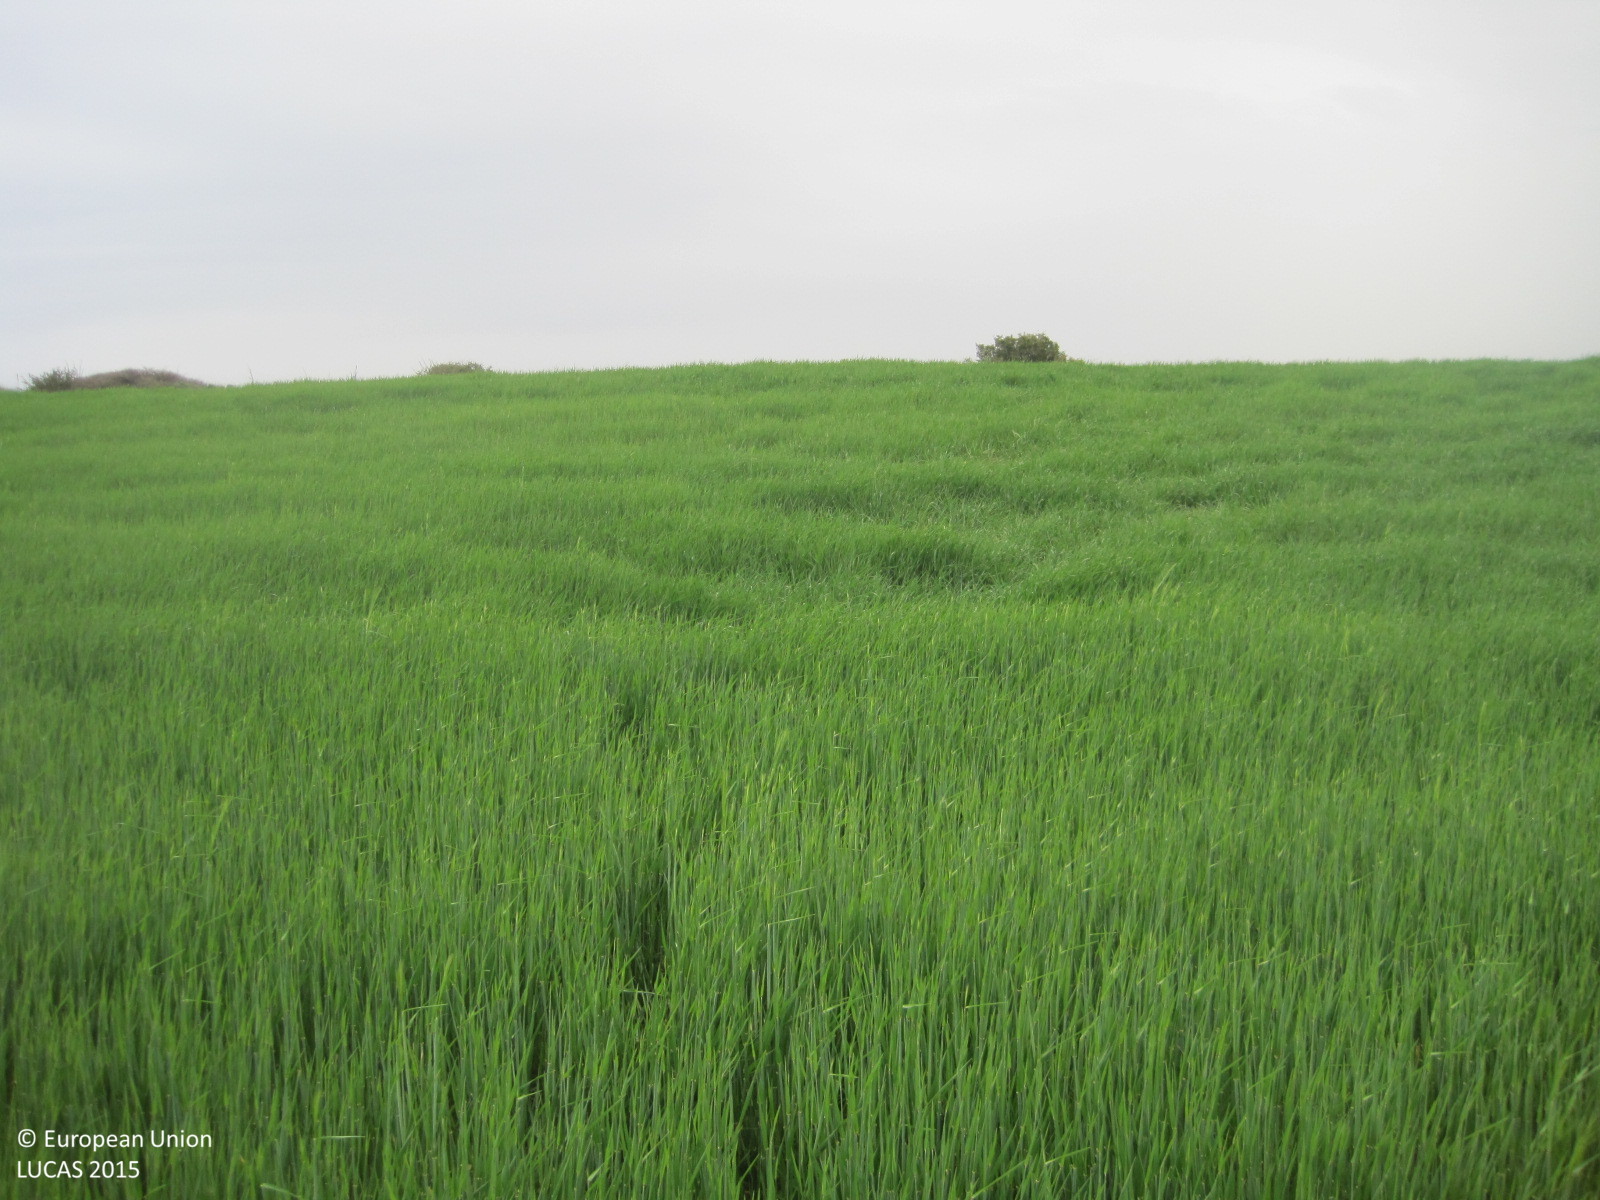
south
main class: Cropland
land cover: Barley
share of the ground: > 75 %
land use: Agriculture (excluding fallow land and kitchen gardens)
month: April
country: ES
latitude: 42.5597
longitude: -2.1369
